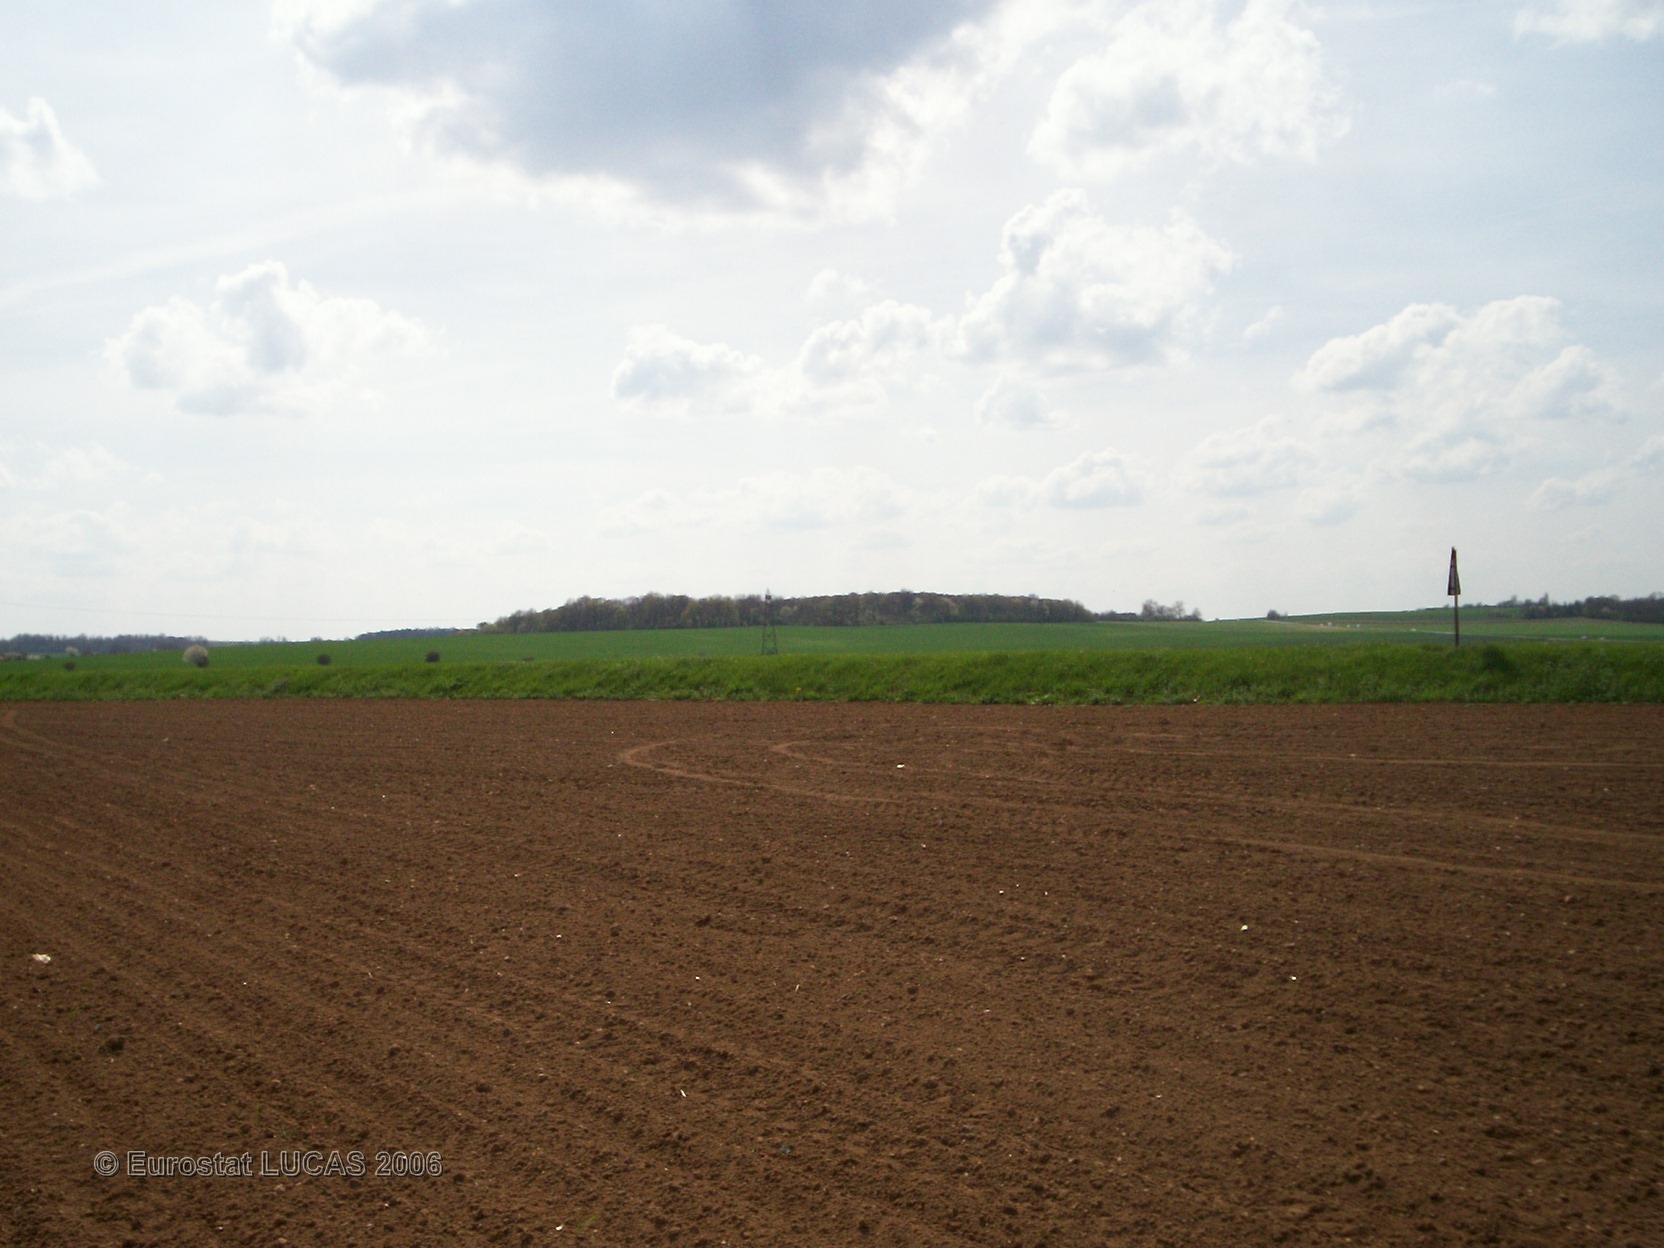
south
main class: Cropland
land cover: Sugar beet
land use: Agriculture (excluding fallow land and kitchen gardens)
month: April
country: FR
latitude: 48.3579
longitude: 2.9334
